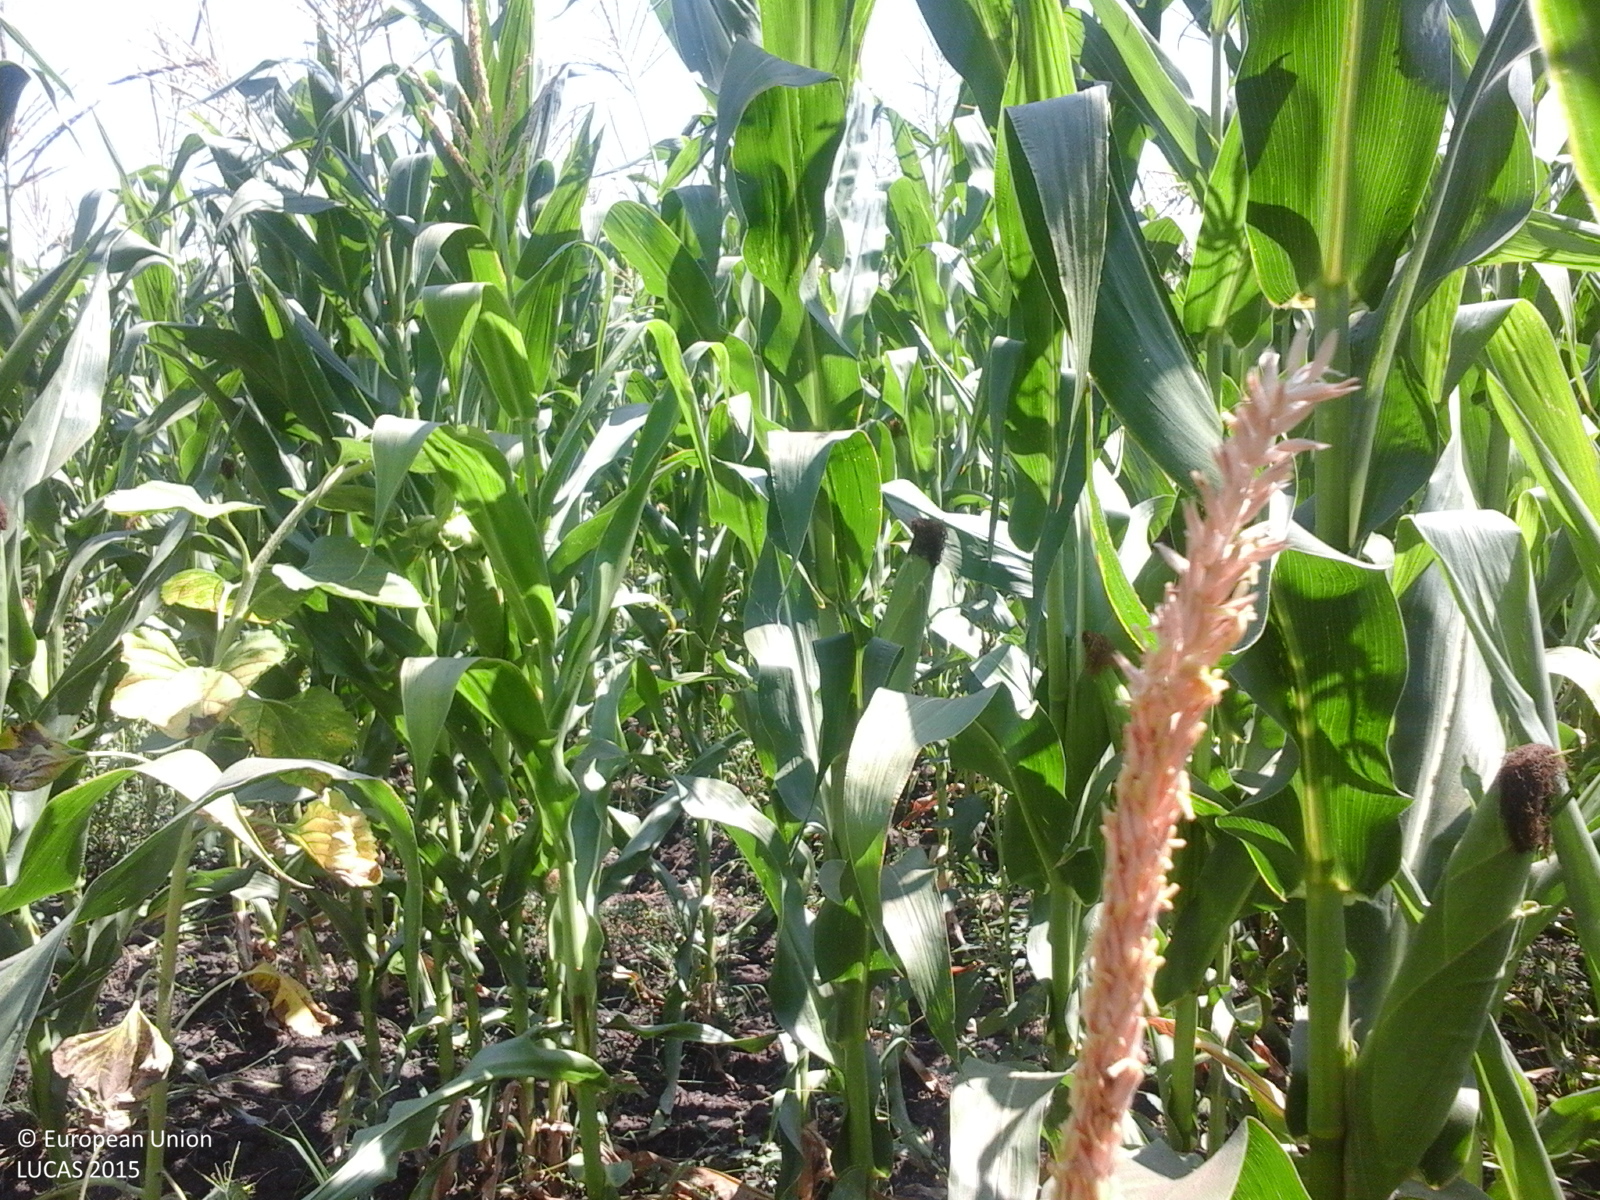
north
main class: Cropland
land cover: Maize
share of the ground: > 75 %
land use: Agriculture (excluding fallow land and kitchen gardens)
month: July
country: RO
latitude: 44.8864
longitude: 26.5419
